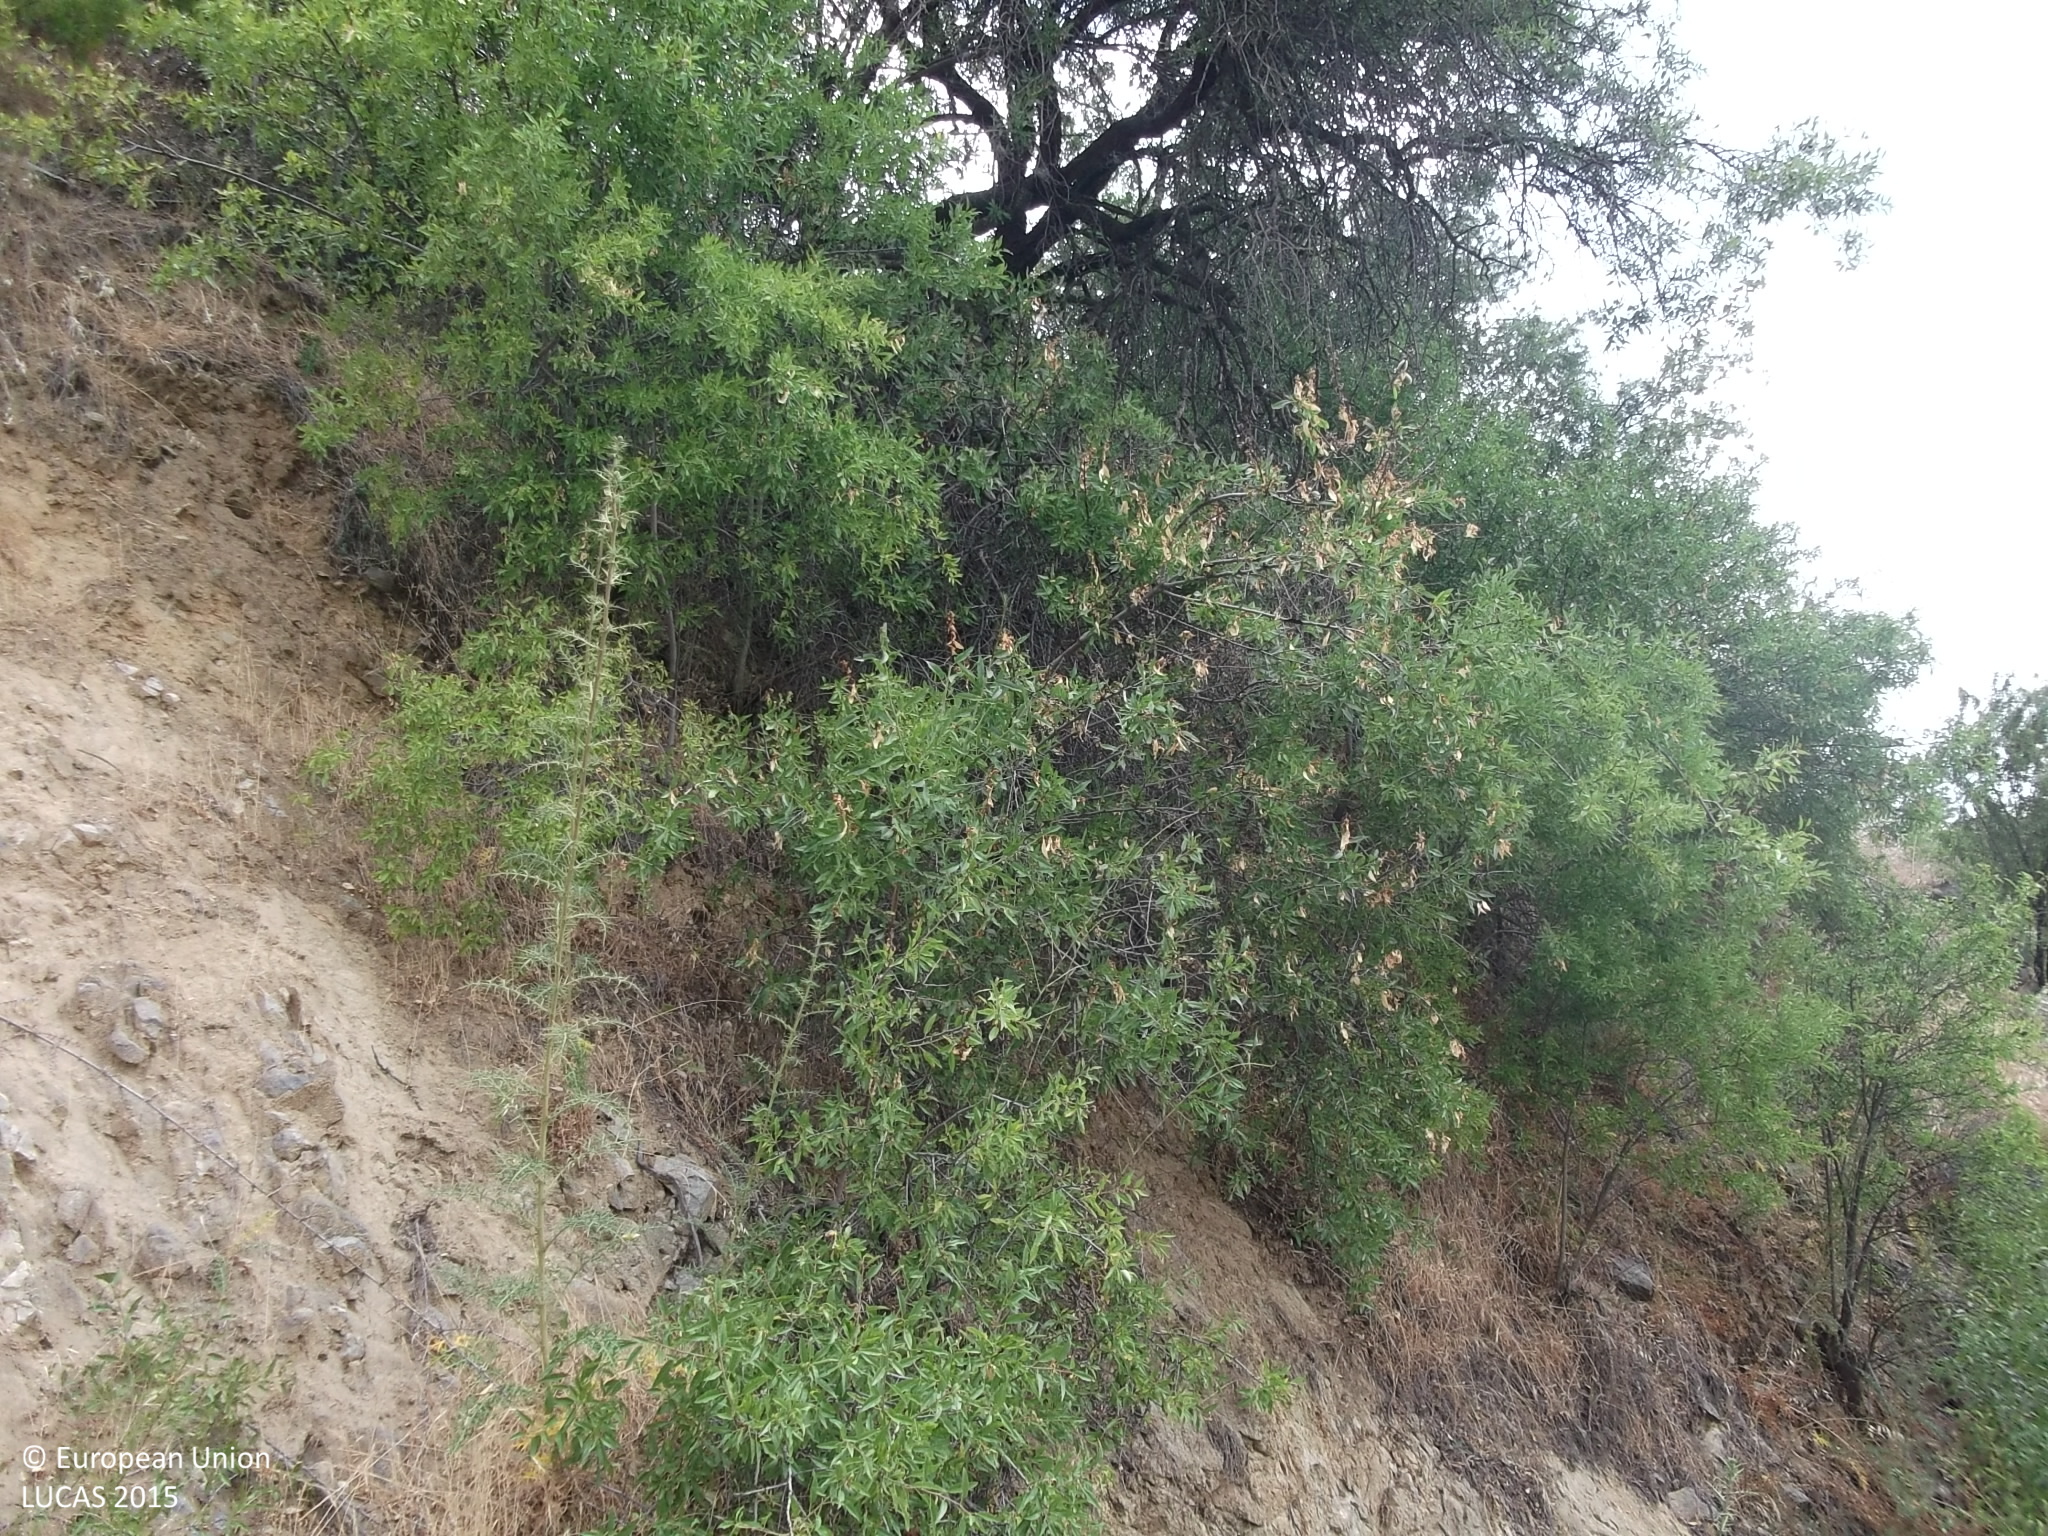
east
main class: Cropland
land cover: Nuts trees
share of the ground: 25 - 50 %
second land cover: Grassland without tree/shrub cover
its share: > 75 %
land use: Agriculture (excluding fallow land and kitchen gardens)
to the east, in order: Nuts trees; Grassland without tree/shrub cover; Tracks; Nuts trees; Dry stone walls; Nuts trees; Dry stone walls; Nuts trees; Dry stone walls; Nuts trees; Tracks; Other fruit trees and berries; Olive groves; Artificial constructions in urban areas
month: June
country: CY
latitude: 34.8971
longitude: 32.9634
